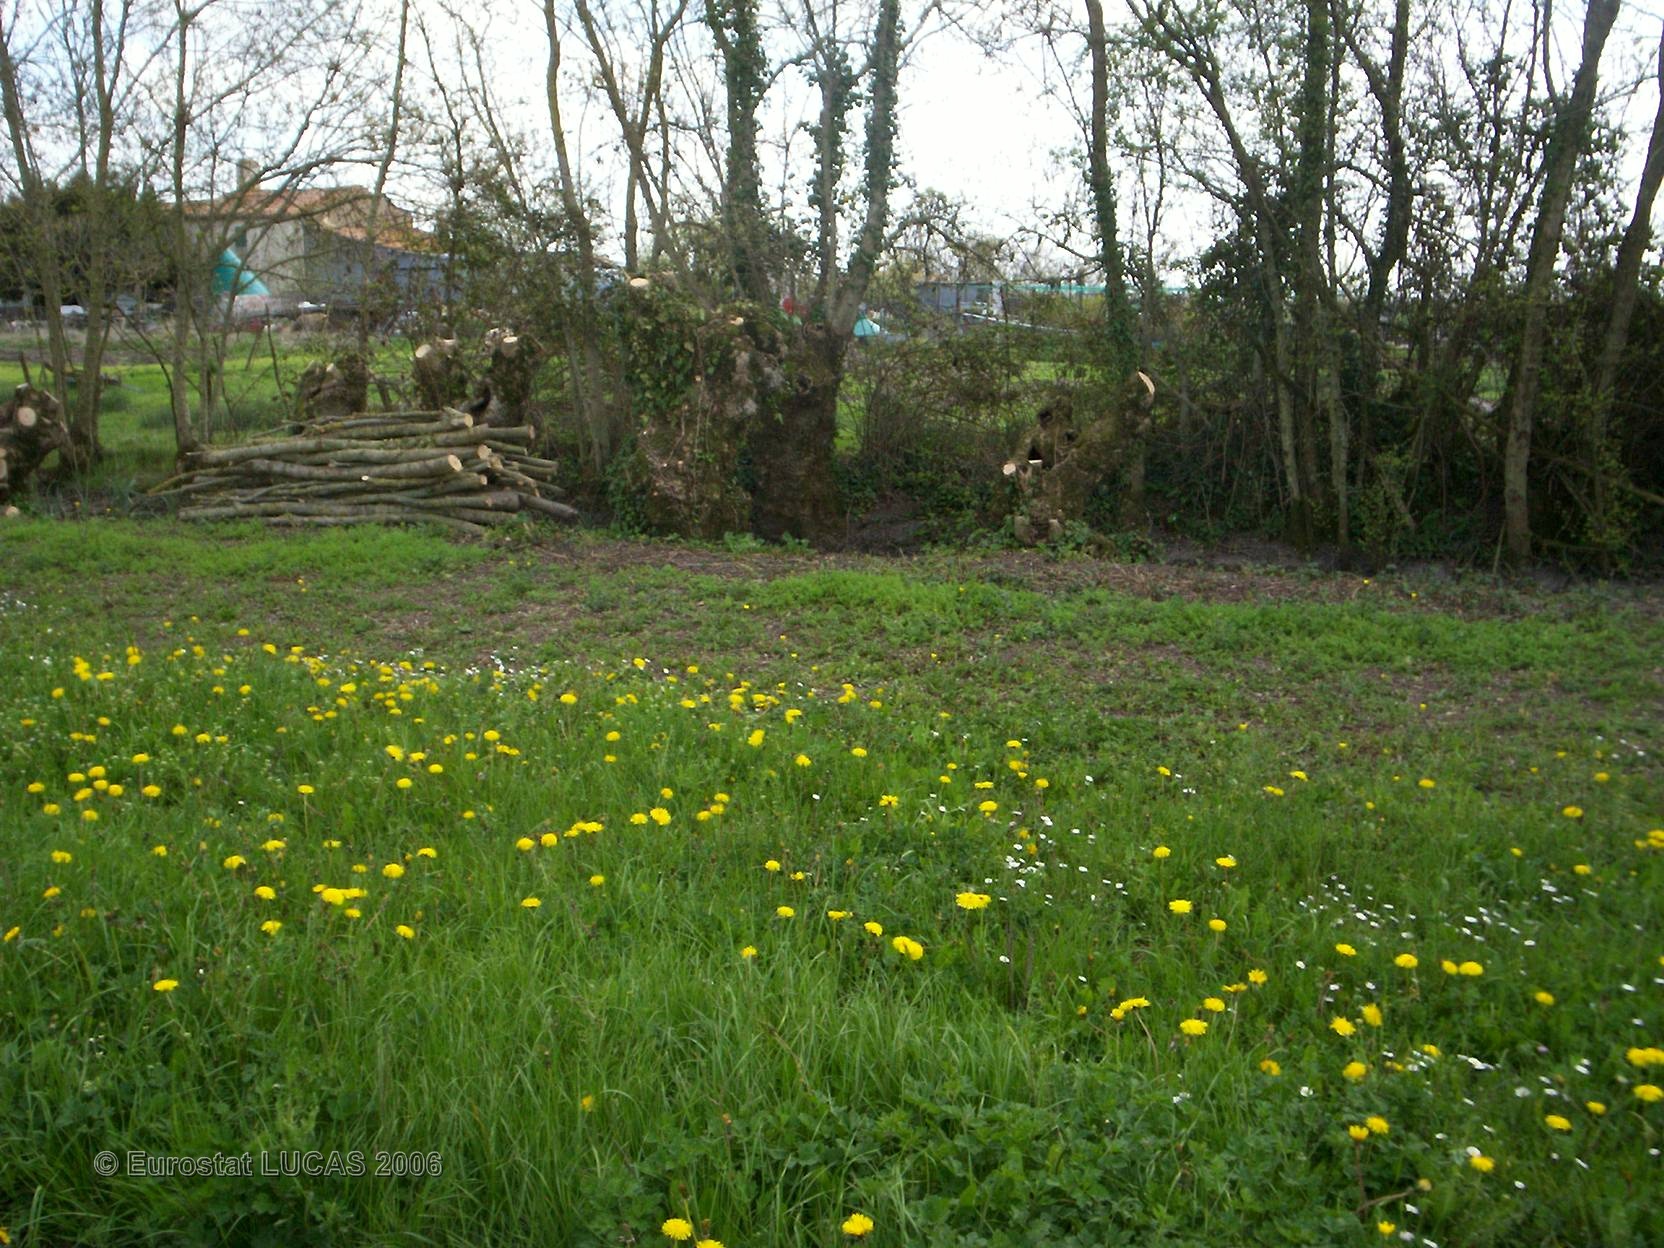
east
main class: Grassland
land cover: Grassland without tree/shrub cover
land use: Agriculture (excluding fallow land and kitchen gardens)
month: April
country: FR
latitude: 46.3140
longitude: -0.9517
